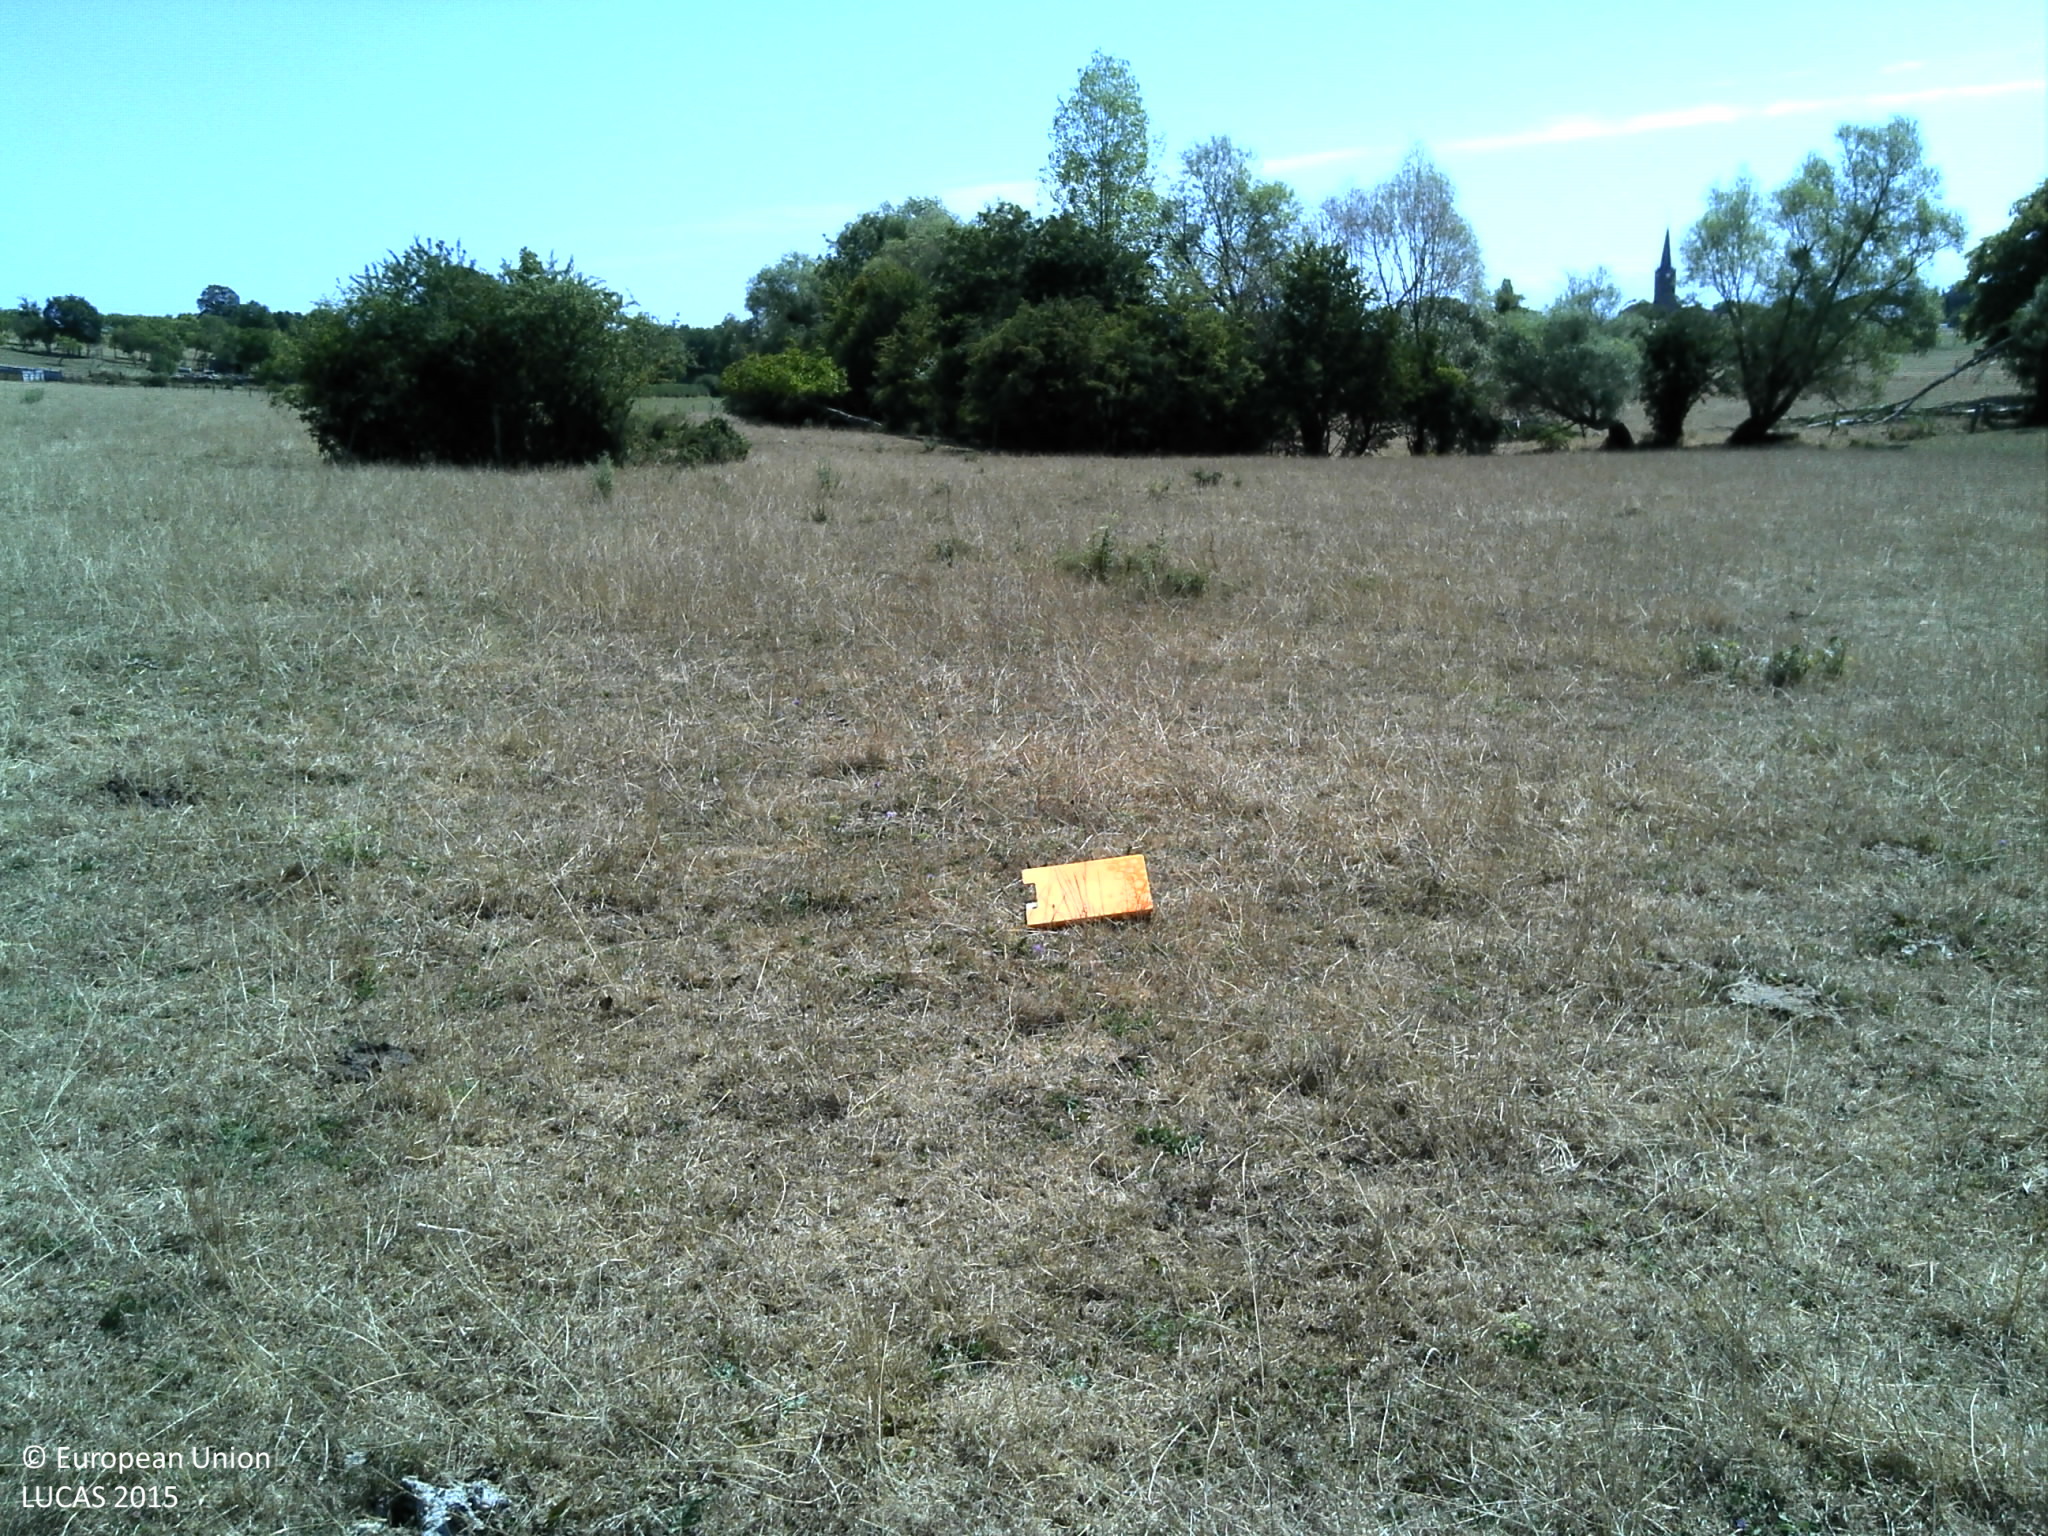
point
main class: Grassland
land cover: Grassland with sparse tree/shrub cover
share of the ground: > 75 %
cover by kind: herbaceous plants 95 %, broadleaved forest trees 5 %
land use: Agriculture (excluding fallow land and kitchen gardens)
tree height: < 5 m
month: July
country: FR
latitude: 48.3329
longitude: 6.0478
